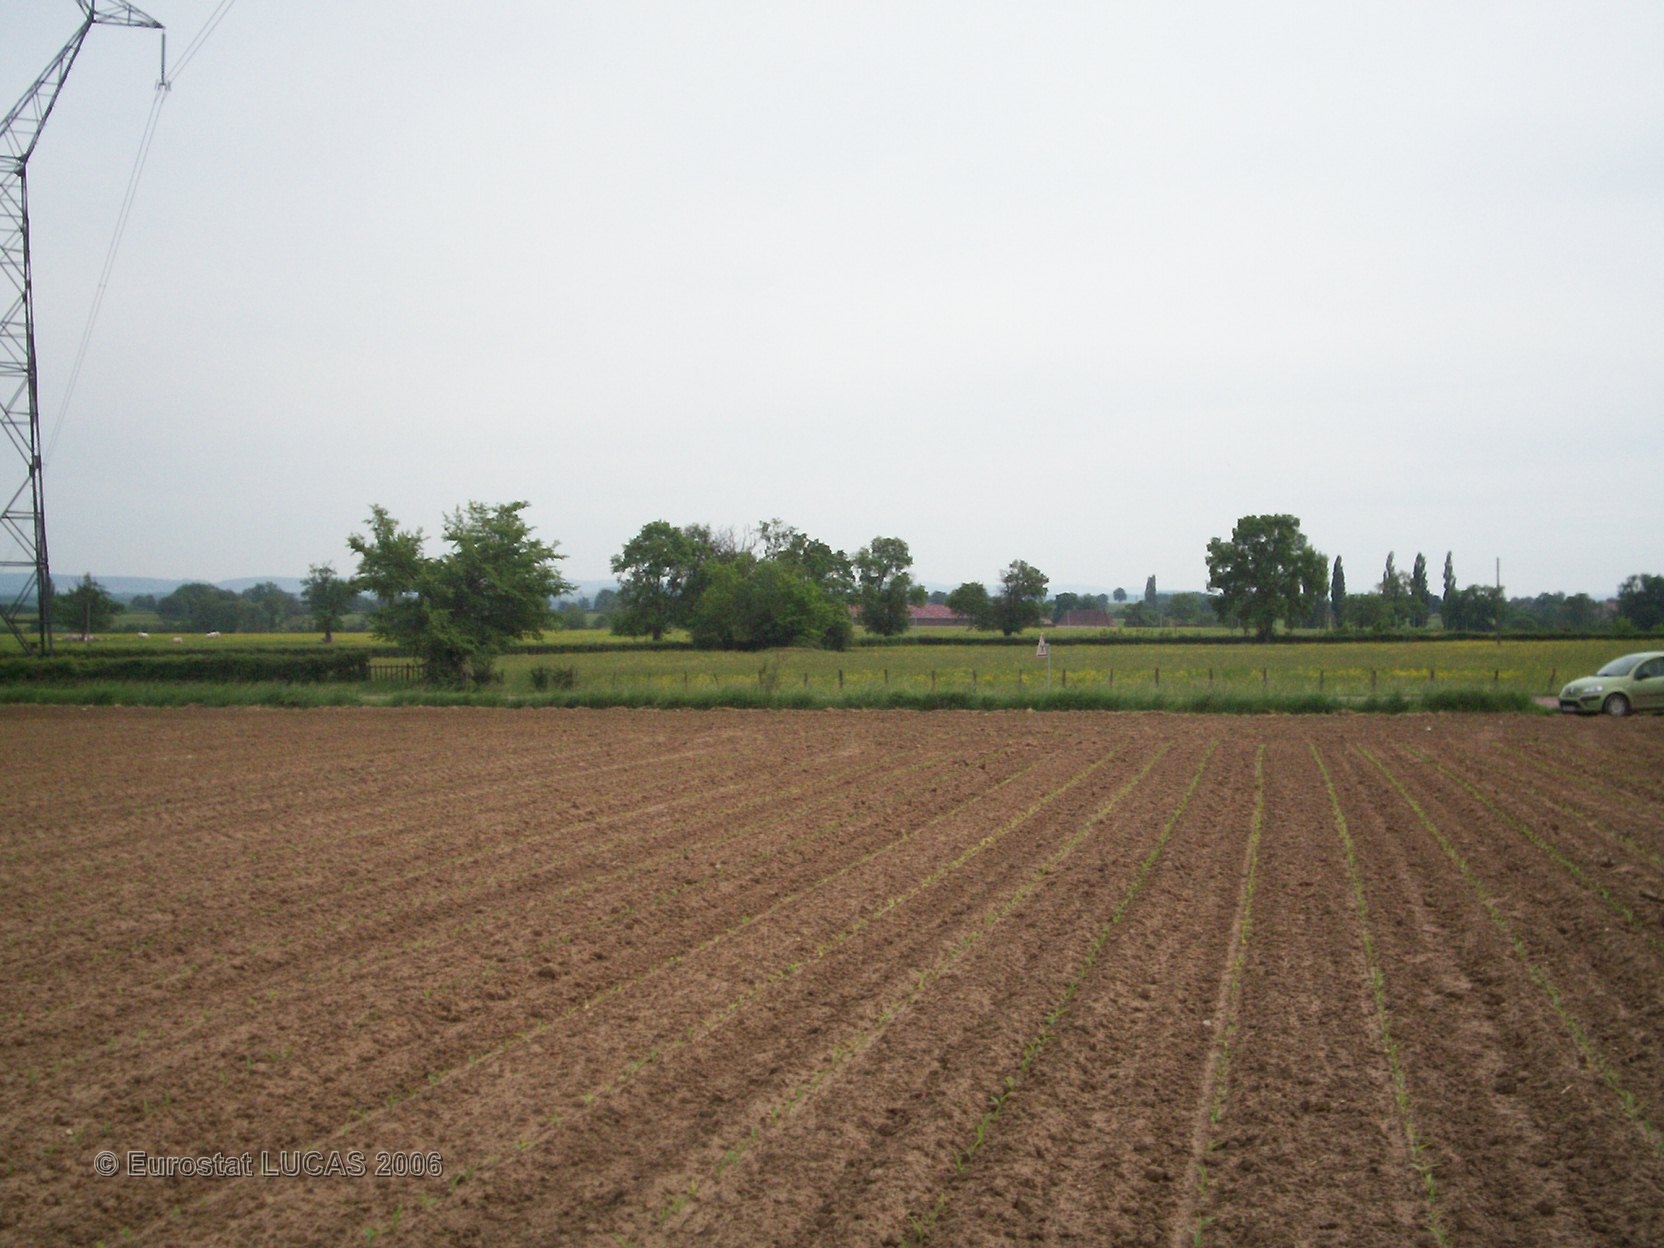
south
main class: Cropland
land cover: Maize
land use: Agriculture (excluding fallow land and kitchen gardens)
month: May
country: FR
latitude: 46.6534
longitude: 4.7092
